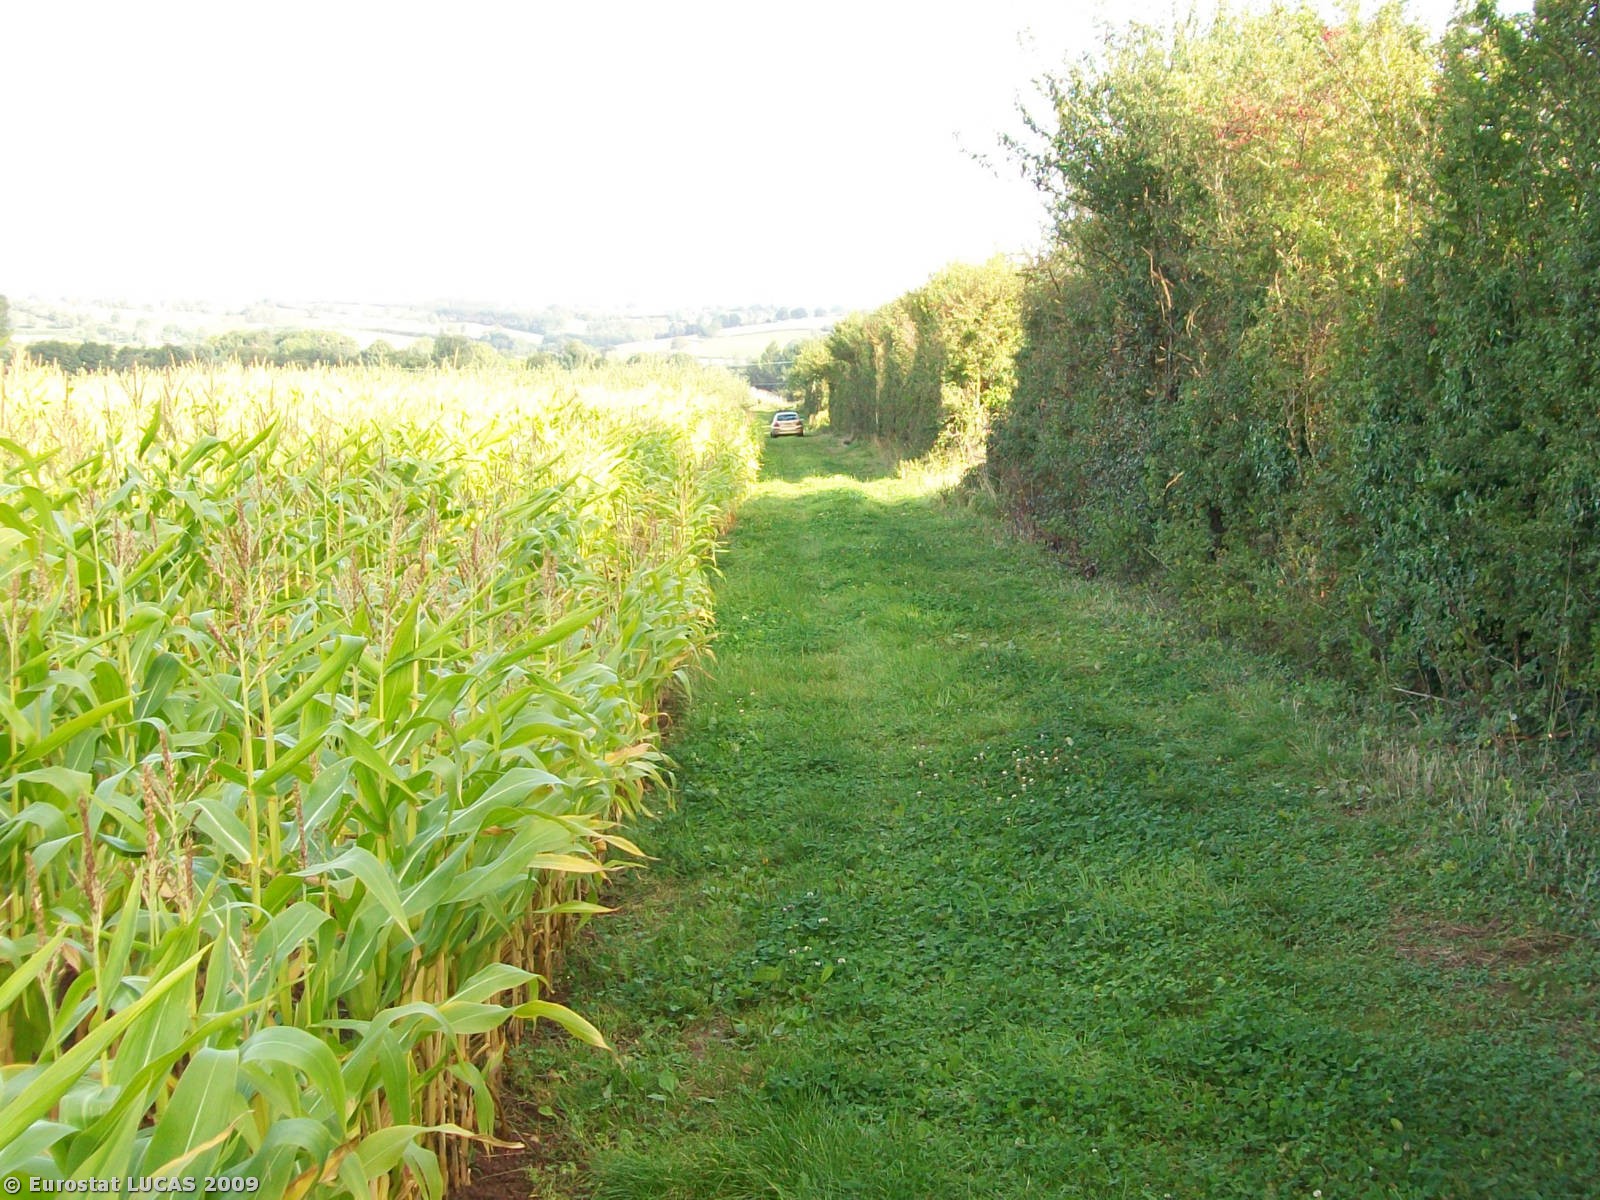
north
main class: Cropland
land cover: Maize
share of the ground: 25 - 50 %
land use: Agriculture (excluding fallow land and kitchen gardens)
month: September
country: GB
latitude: 52.1146
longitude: -2.4937
